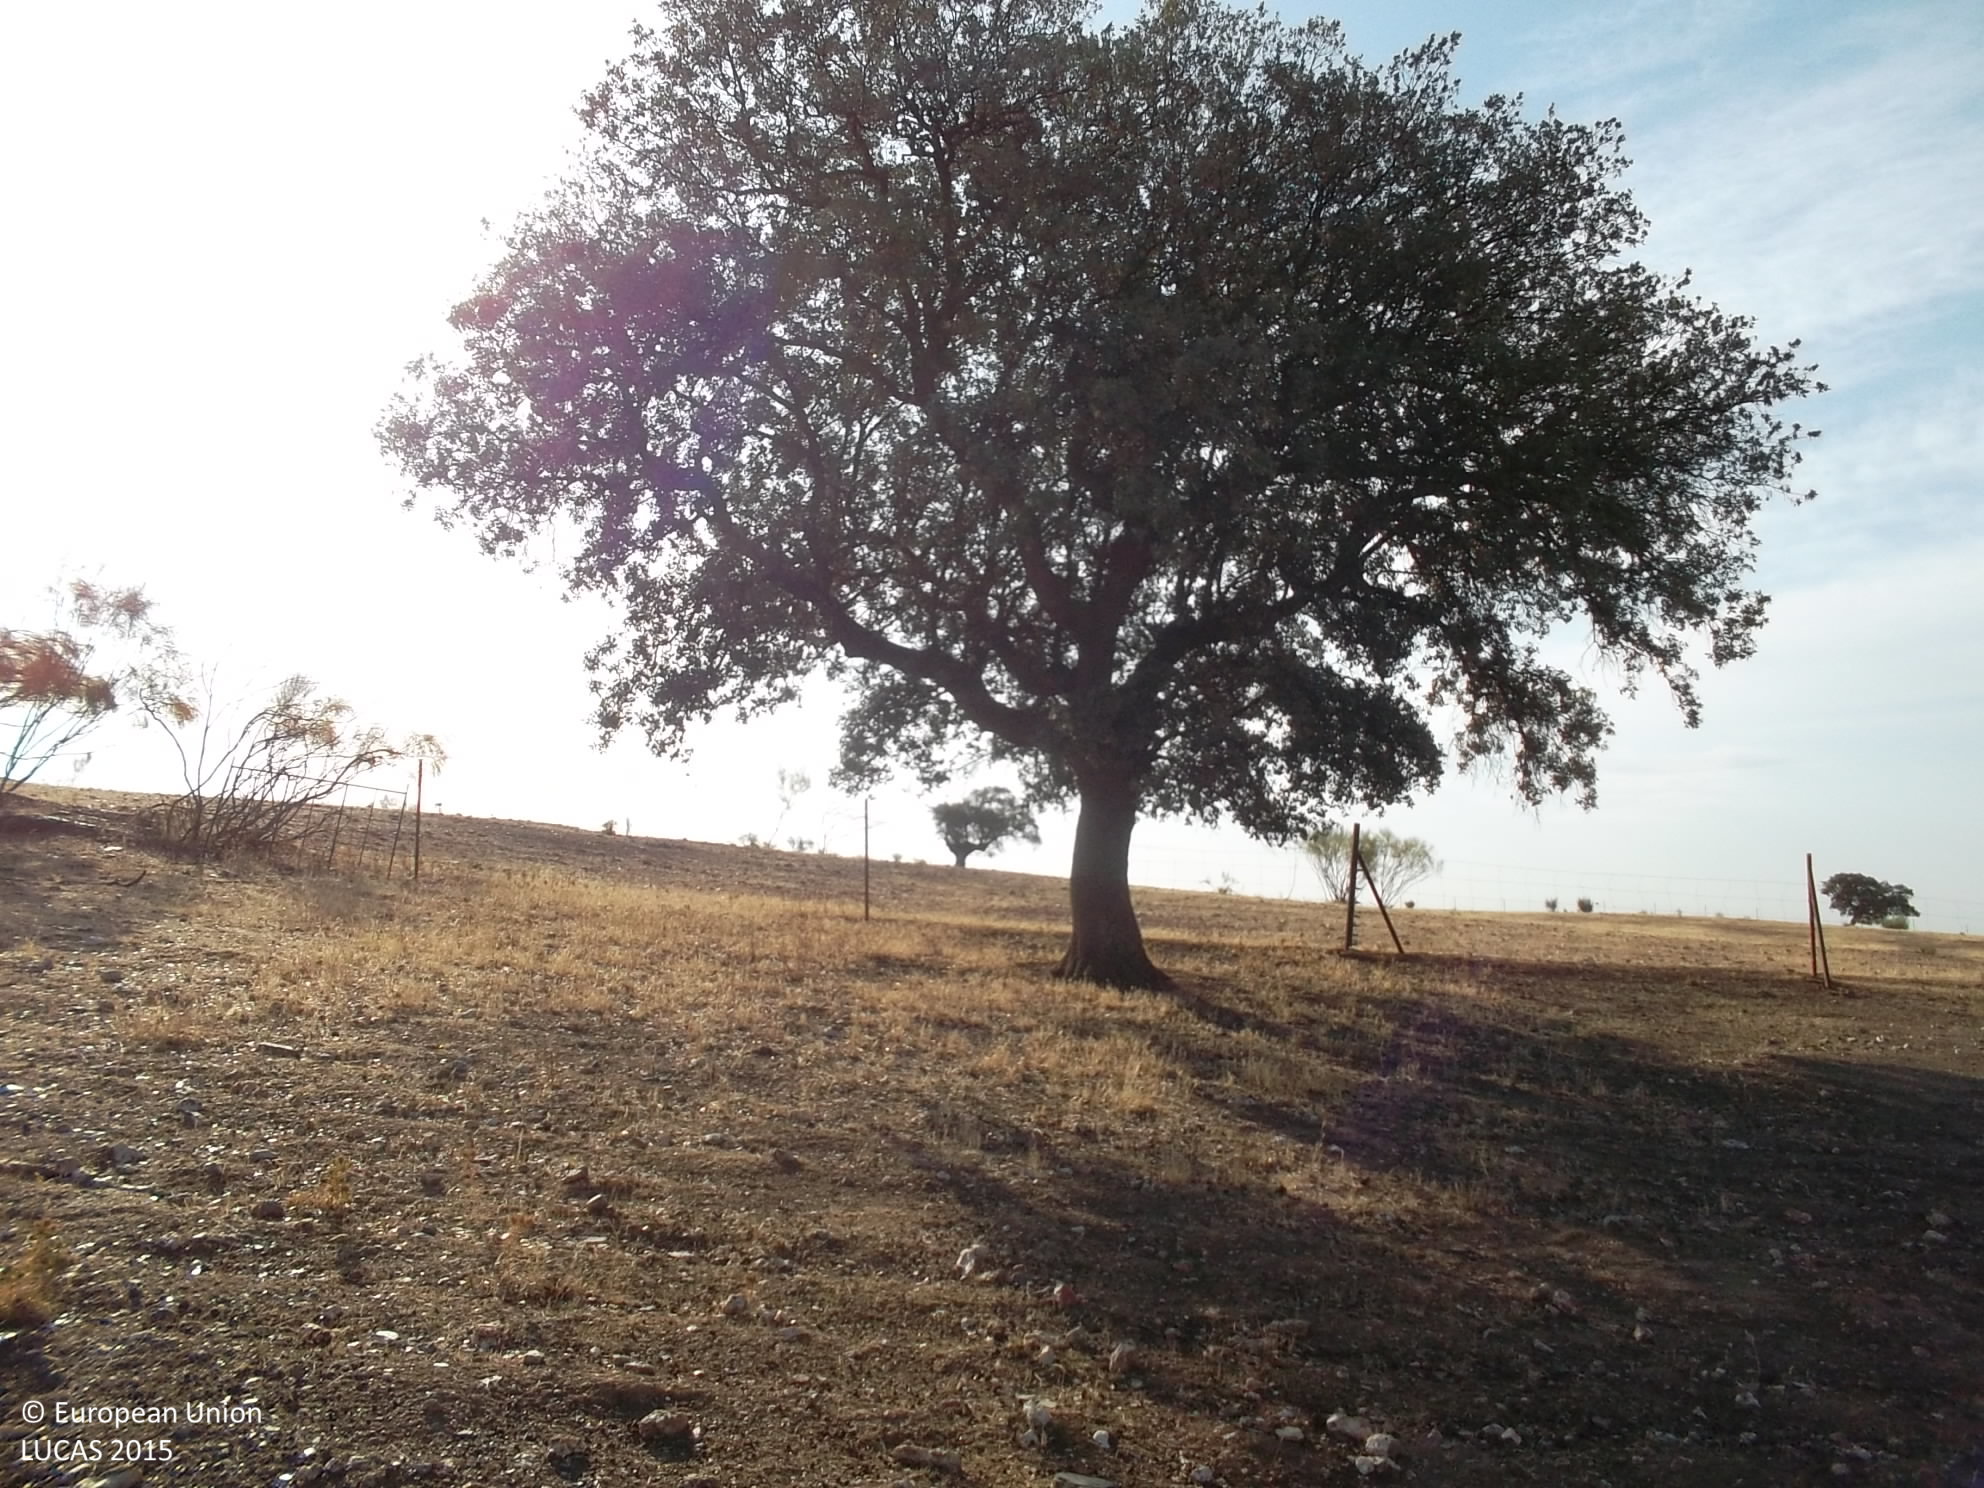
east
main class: Grassland
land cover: Grassland with sparse tree/shrub cover
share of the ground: > 75 %
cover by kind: herbaceous plants 95 %, broadleaved forest trees 5 %
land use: Agriculture (excluding fallow land and kitchen gardens)
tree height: > 5 m
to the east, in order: Grassland with sparse tree/shrub cover; Fences; Grassland without tree/shrub cover; Rock outcrops; Grassland with sparse tree/shrub cover; Fences; Grassland with sparse tree/shrub cover
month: July
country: ES
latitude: 38.5648
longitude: -5.4022
